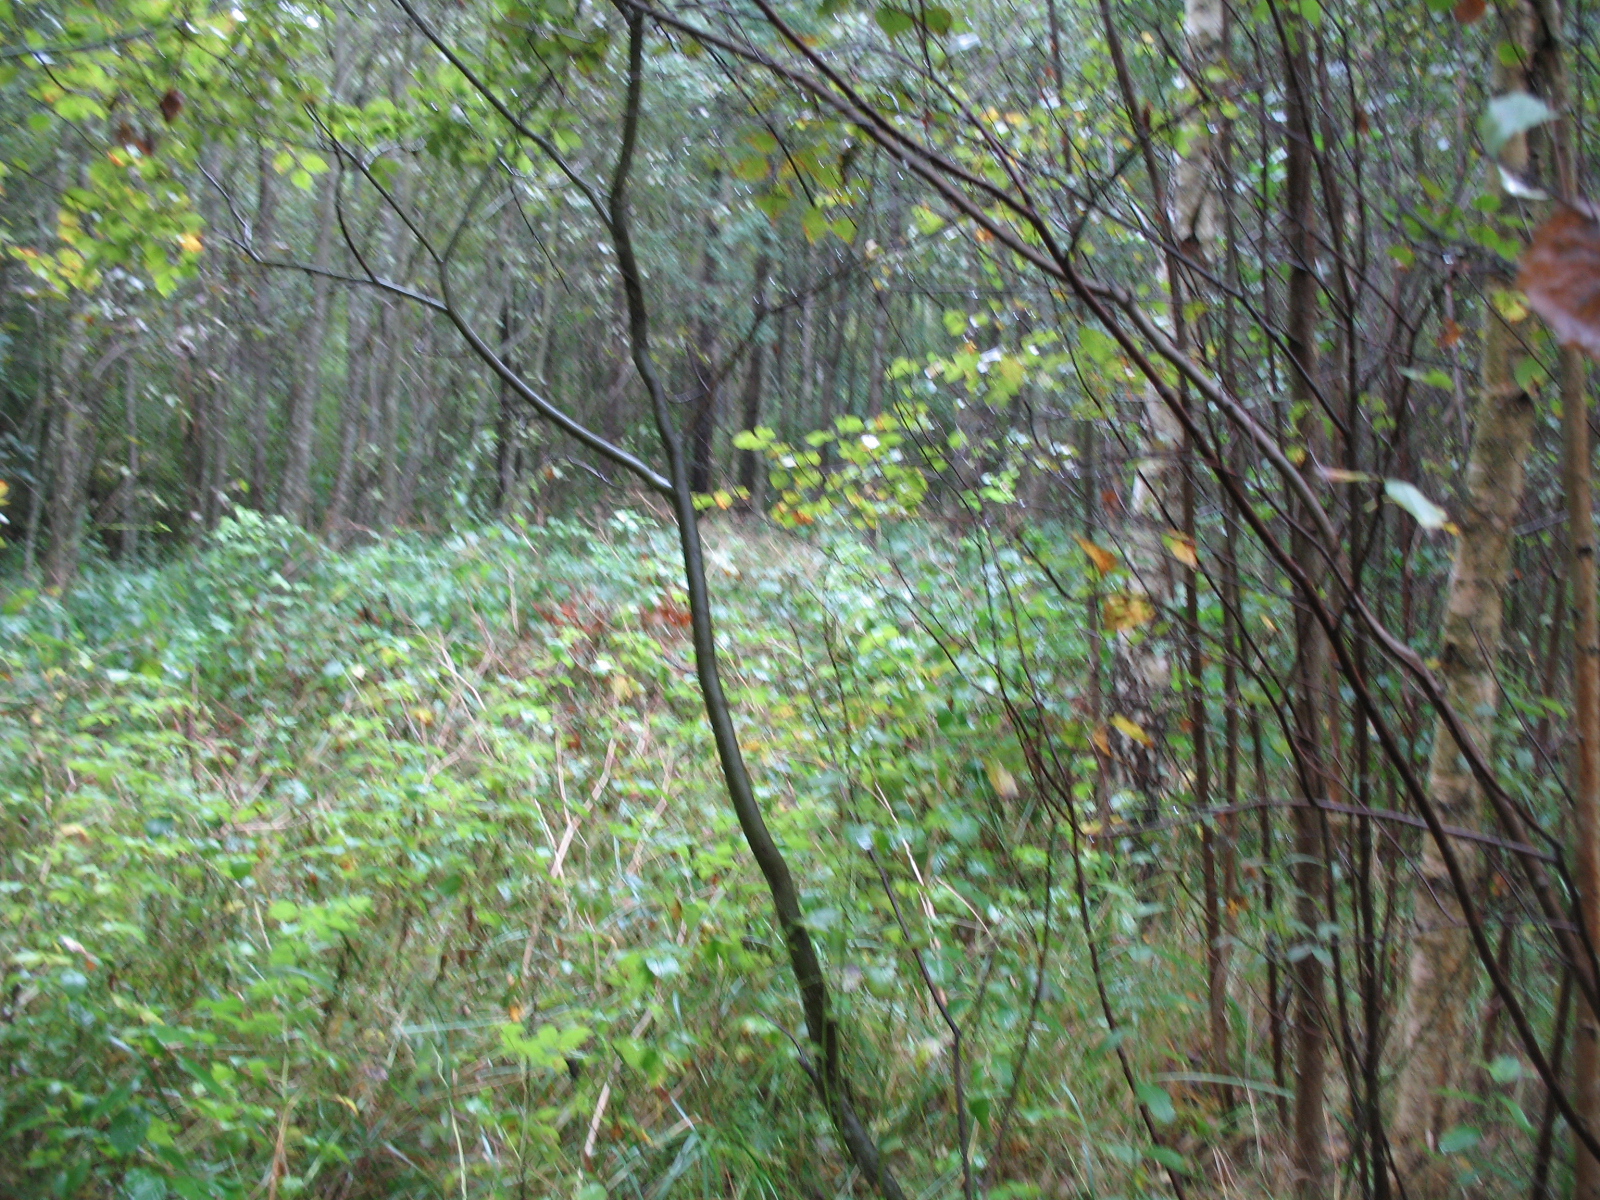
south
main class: Woodland
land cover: Broadleaved woodland
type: non-riverine alder, birch or aspen forest
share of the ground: 50 - 75 %
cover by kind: broadleaved forest trees 70 %, herbaceous plants 30 %
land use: Forestry
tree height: > 5 m
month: September
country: LV
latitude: 56.0174
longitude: 25.8693
